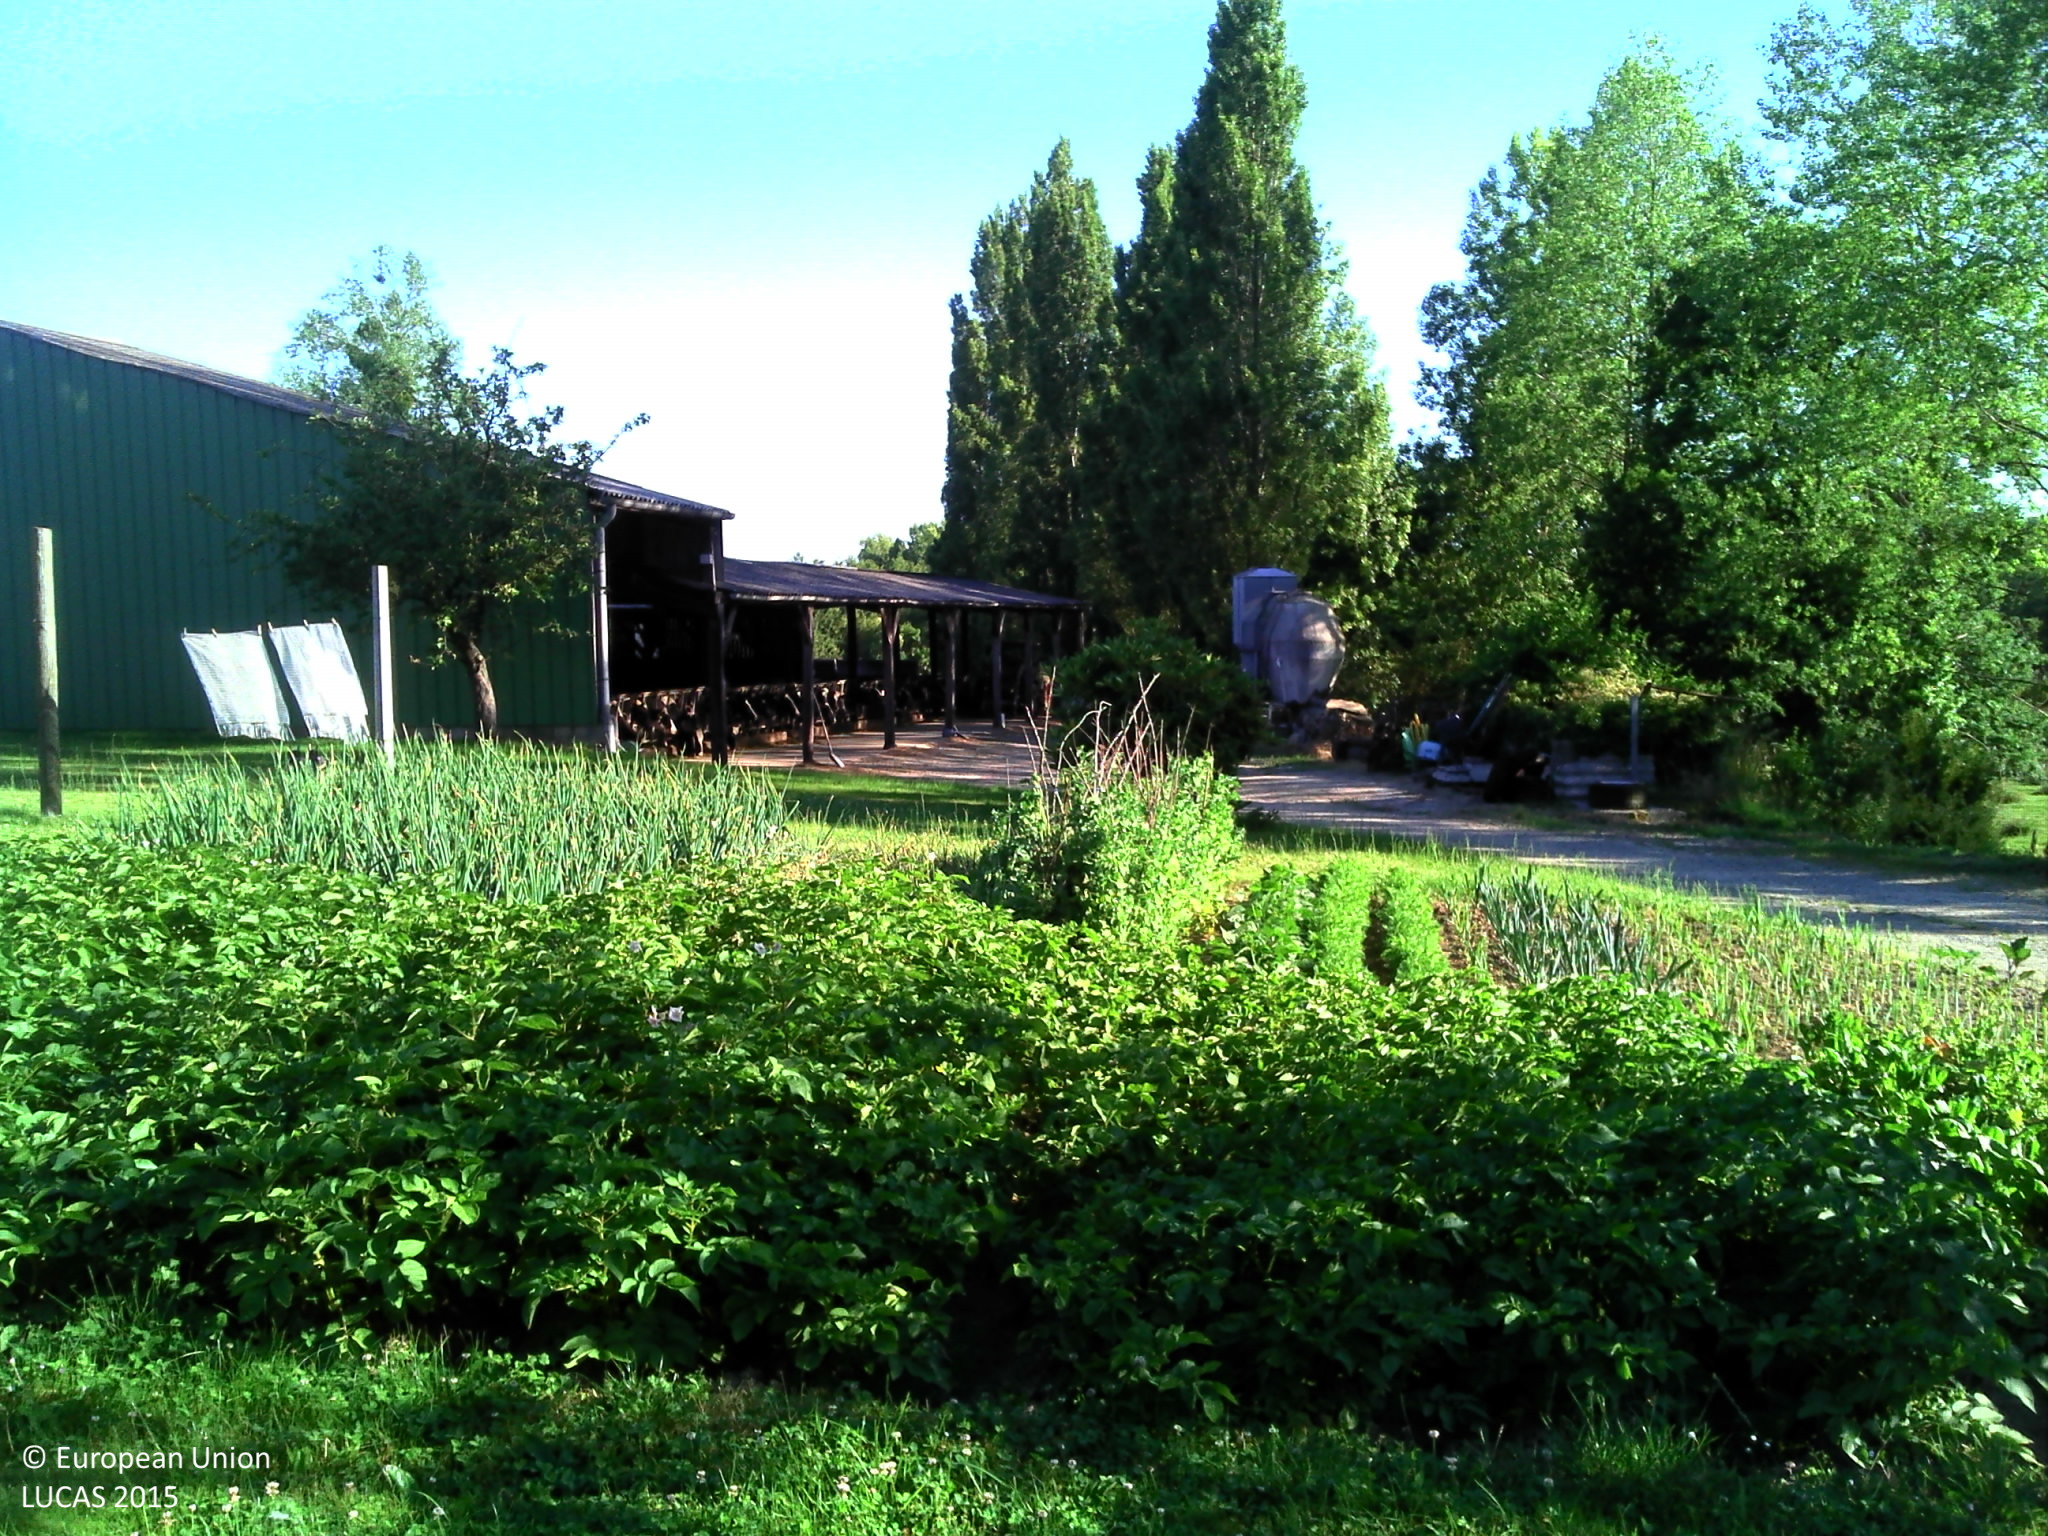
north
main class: Grassland
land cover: Grassland with sparse tree/shrub cover
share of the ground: > 75 %
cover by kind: herbaceous plants 95 %, broadleaved forest trees 5 %
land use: Residential
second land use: Agriculture (excluding fallow land and kitchen gardens)
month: June
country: FR
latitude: 48.5059
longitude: -1.5390
